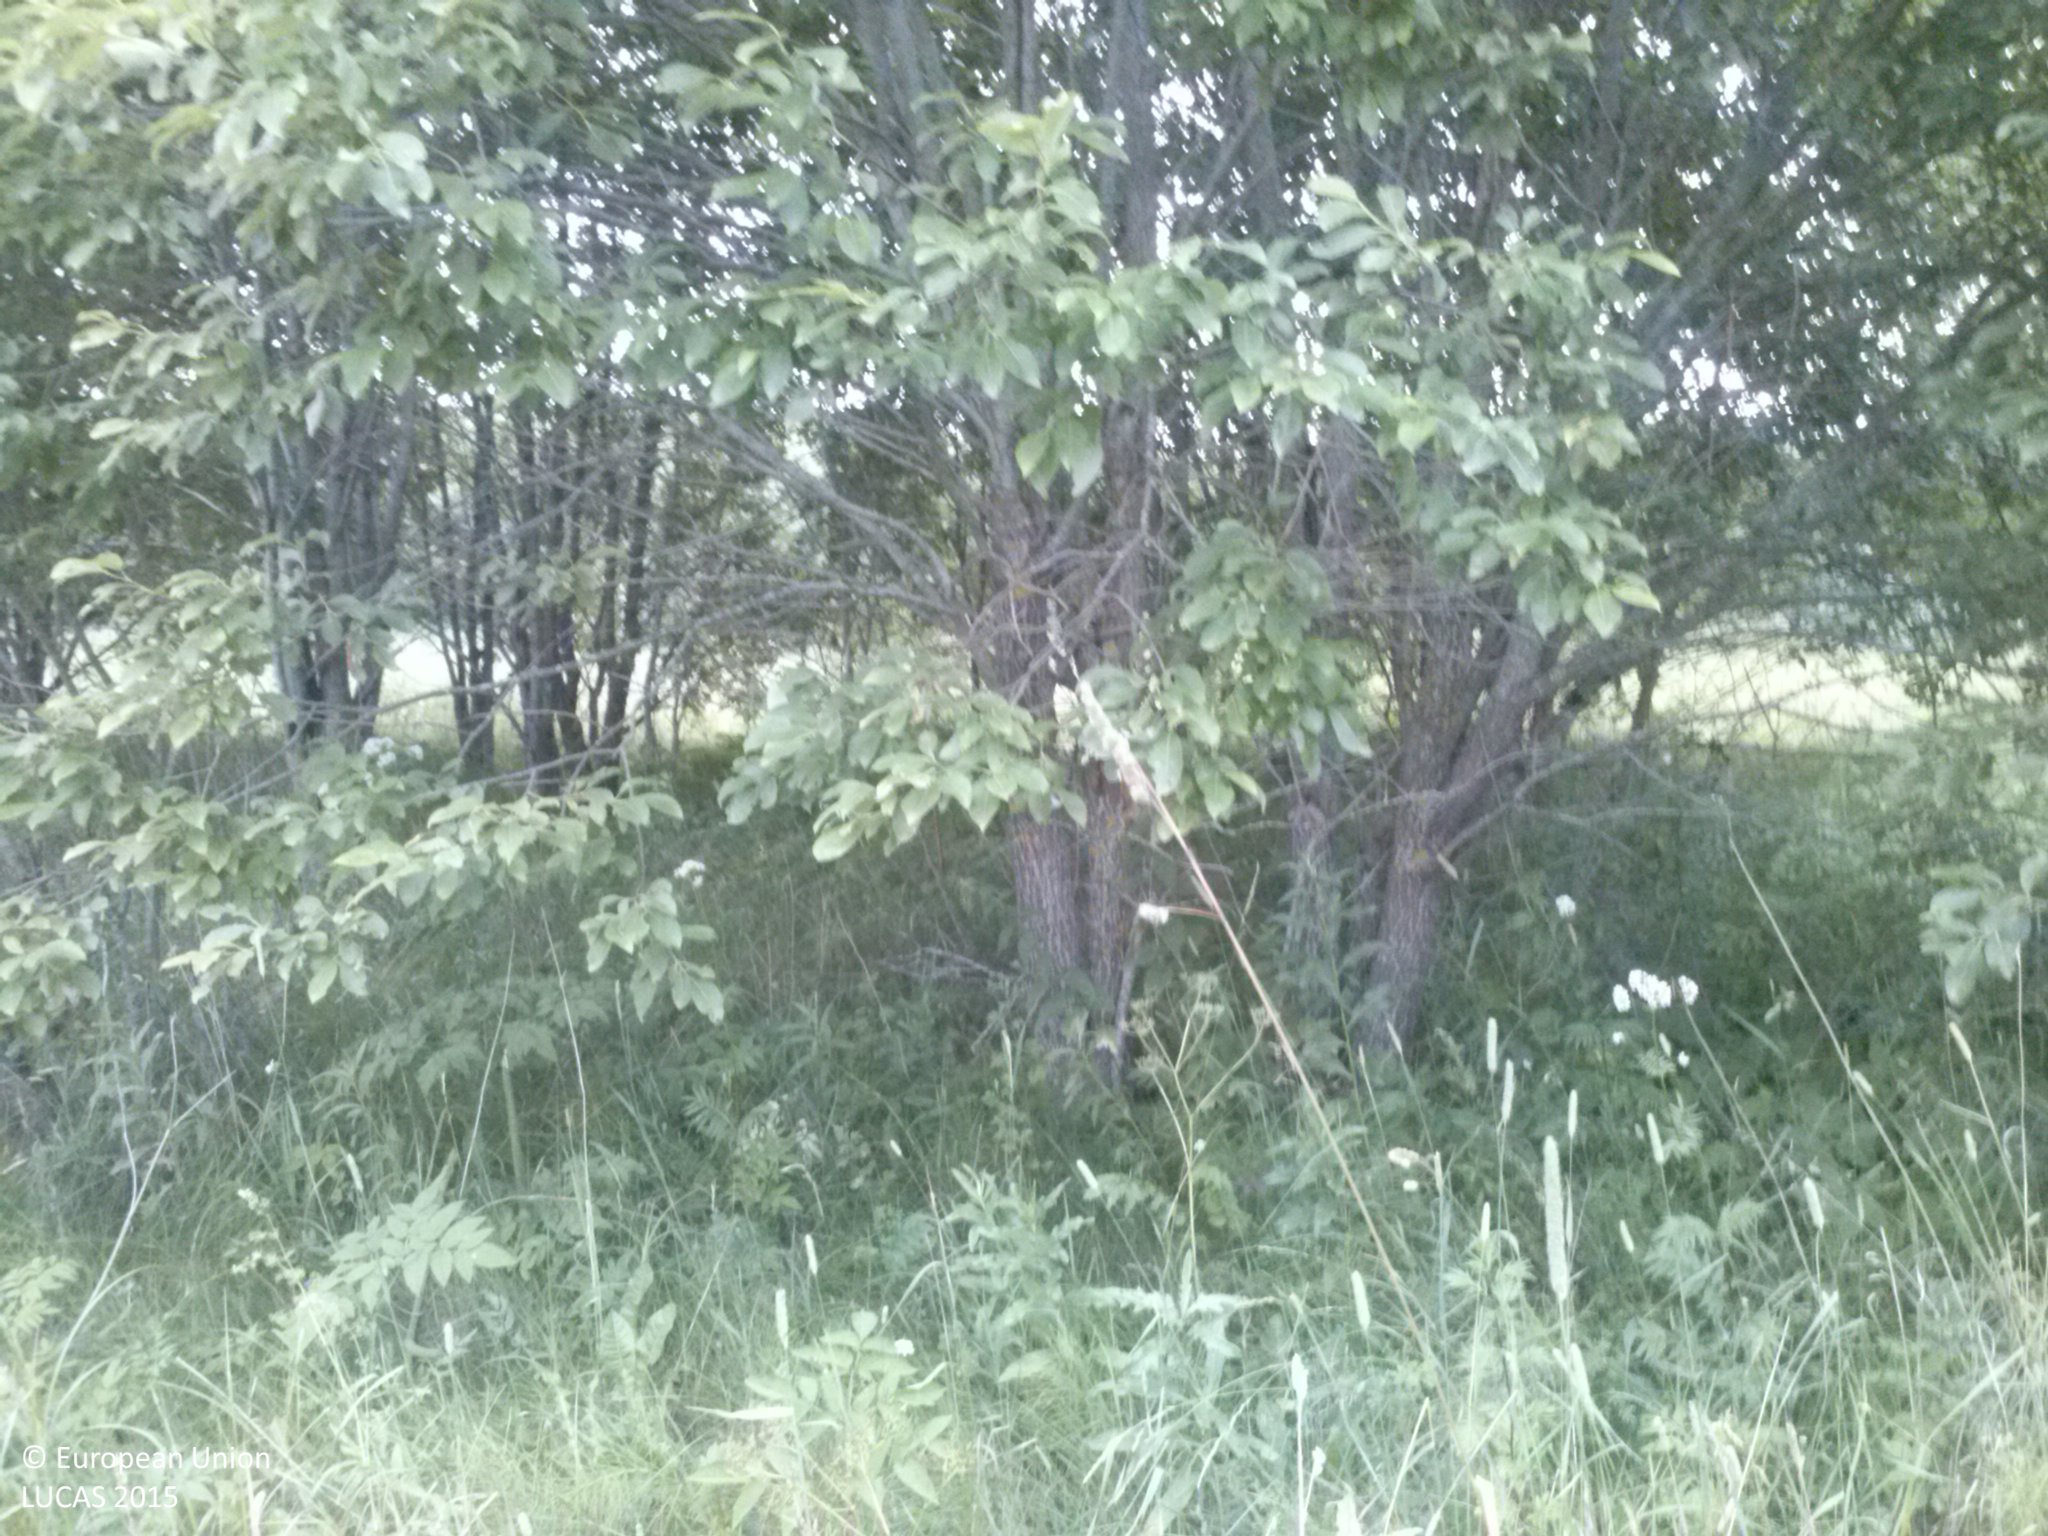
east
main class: Grassland
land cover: Grassland with sparse tree/shrub cover
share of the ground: > 75 %
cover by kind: herbaceous plants 85 %, shrubs 10 %, broadleaved forest trees 5 %
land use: Semi-natural and natural areas not in use
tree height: < 5 m
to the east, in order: Grassland with sparse tree/shrub cover; Shrubland without tree cover; Ditches and canals; Shrubland without tree cover; Common wheat; Shrubland without tree cover; Ditches and canals; Shrubland without tree cover; Barley
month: July
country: LV
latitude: 56.7565
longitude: 27.6682
